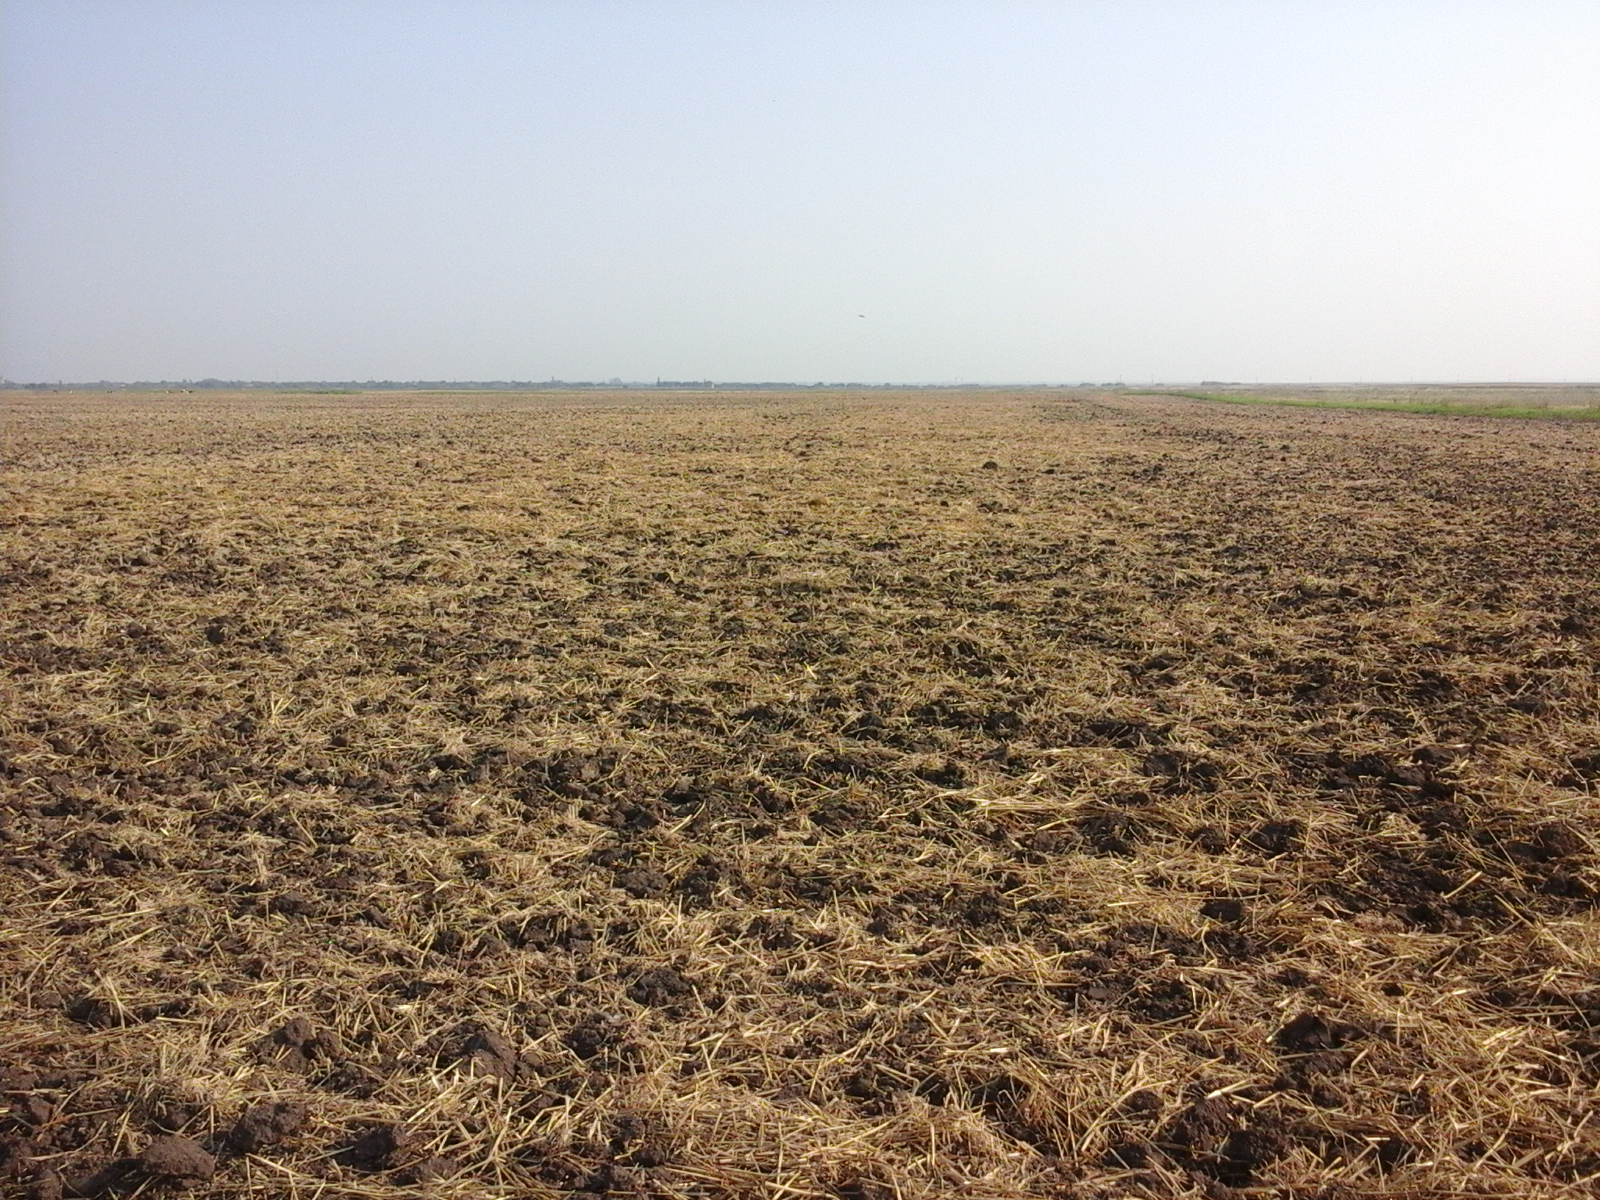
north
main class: Cropland
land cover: Common wheat
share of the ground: 50 - 75 %
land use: Agriculture (excluding fallow land and kitchen gardens)
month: August
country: RO
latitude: 44.0140
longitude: 23.4832
